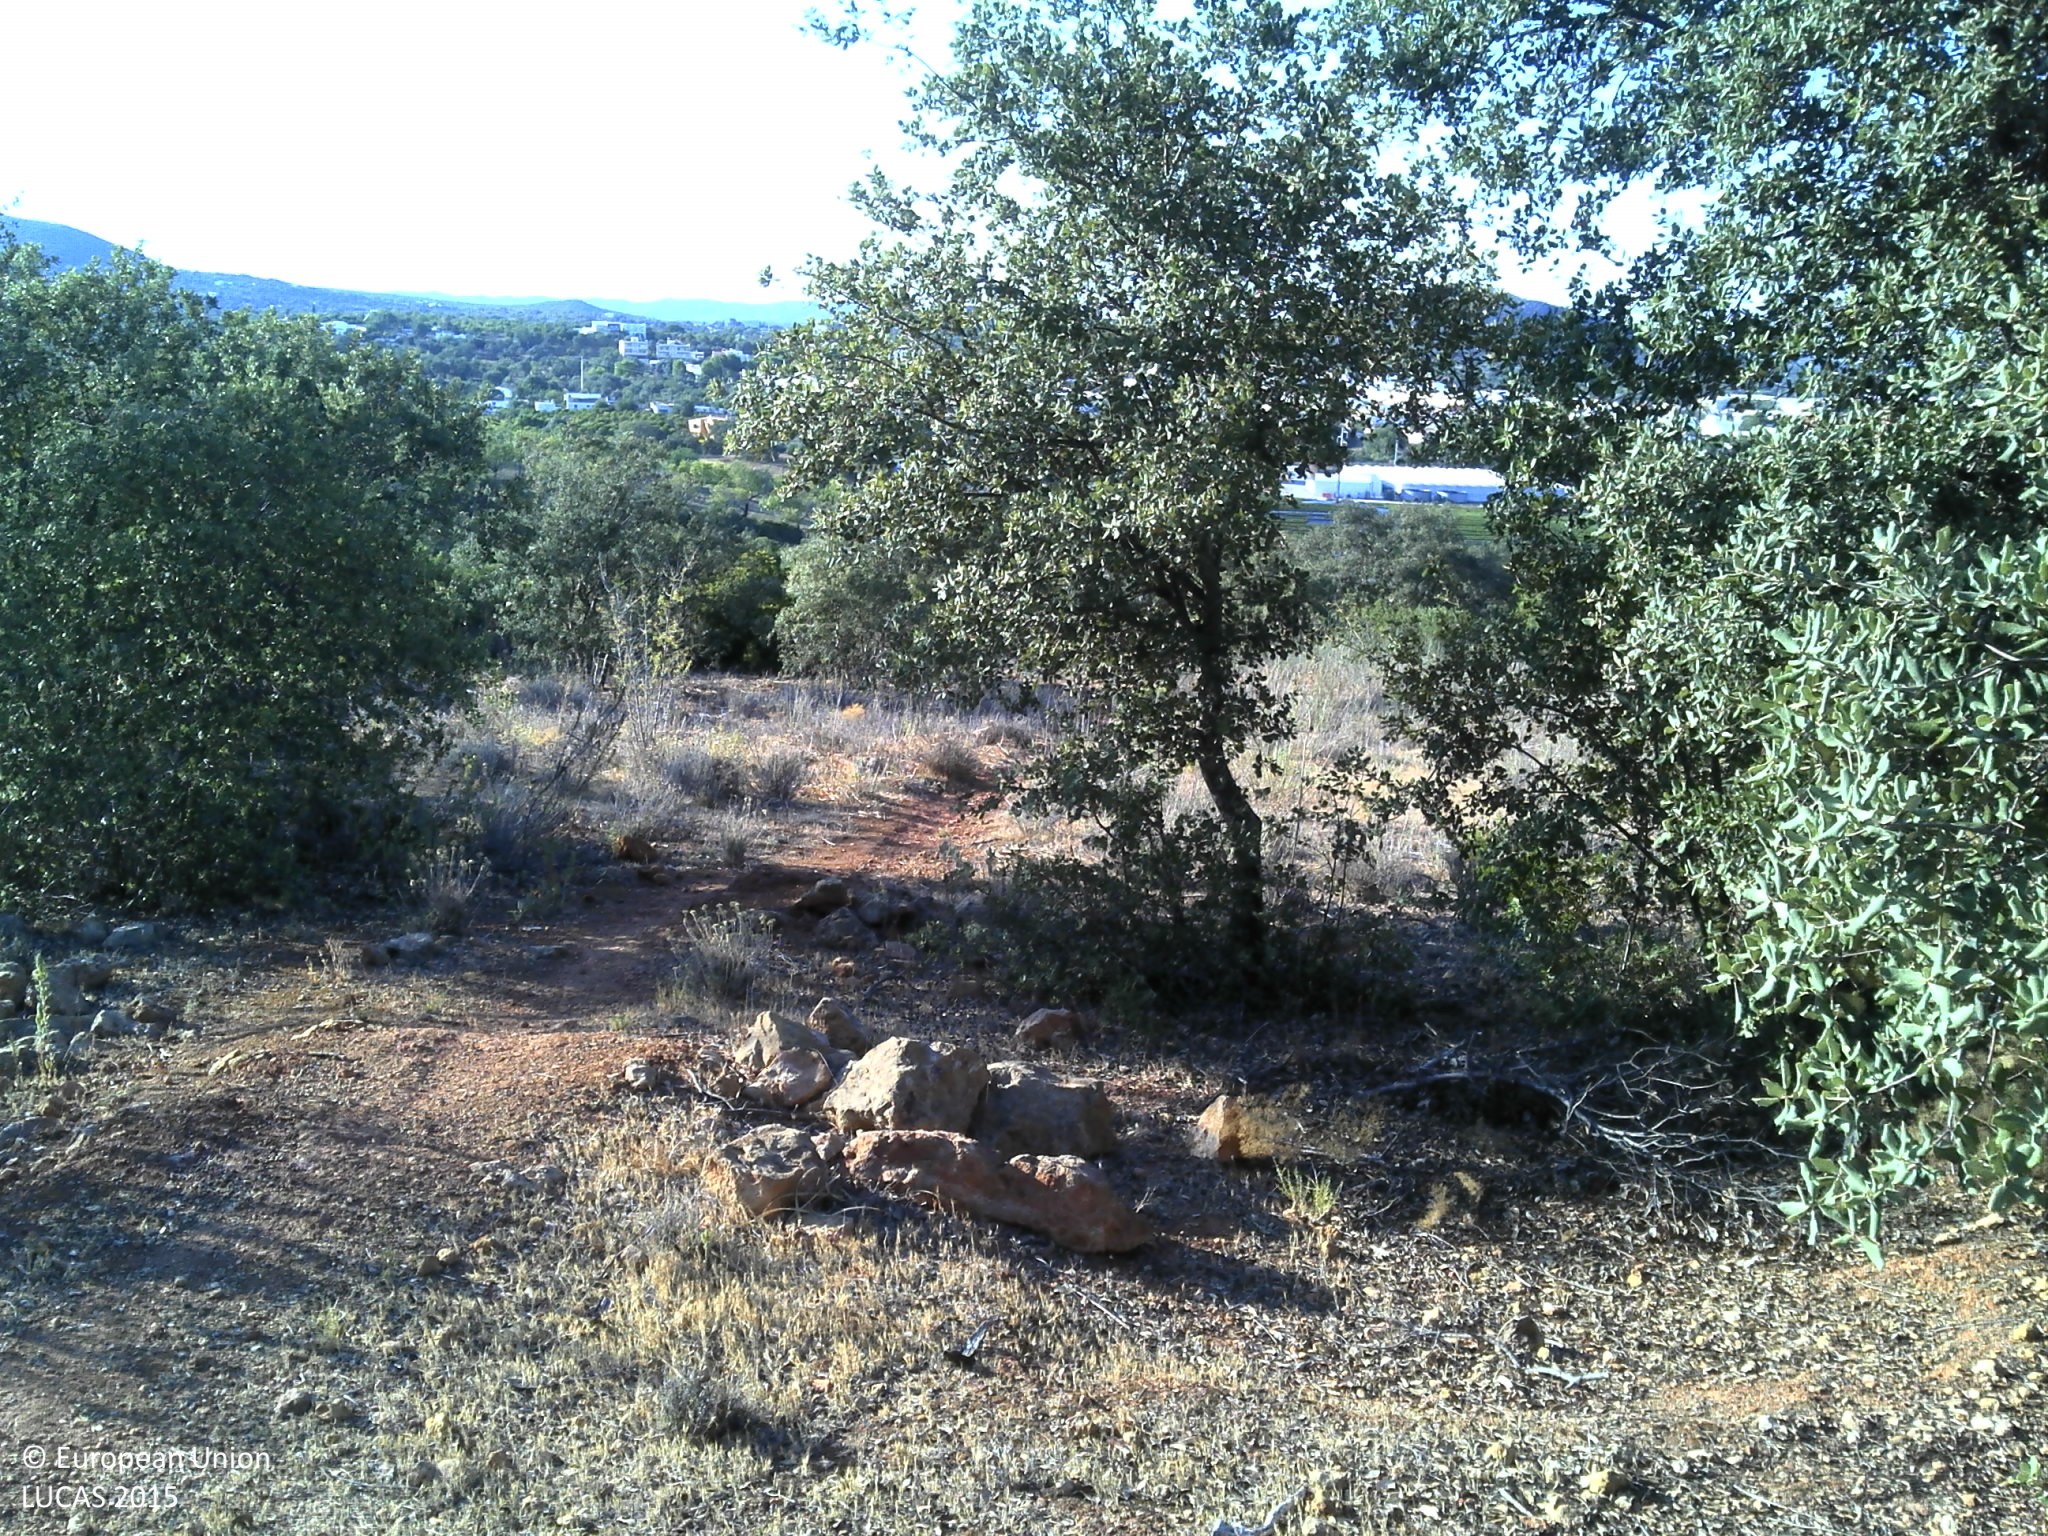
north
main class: Woodland
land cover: Broadleaved woodland
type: broadleaved evergreen forest
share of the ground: 10 - 25 %
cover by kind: unconsolidated bare surface 50 %, broadleaved forest trees 25 %, herbaceous plants 25 %
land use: Forestry
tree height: < 5 m
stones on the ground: < 10 %
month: June
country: PT
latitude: 37.0736
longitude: -7.7895
